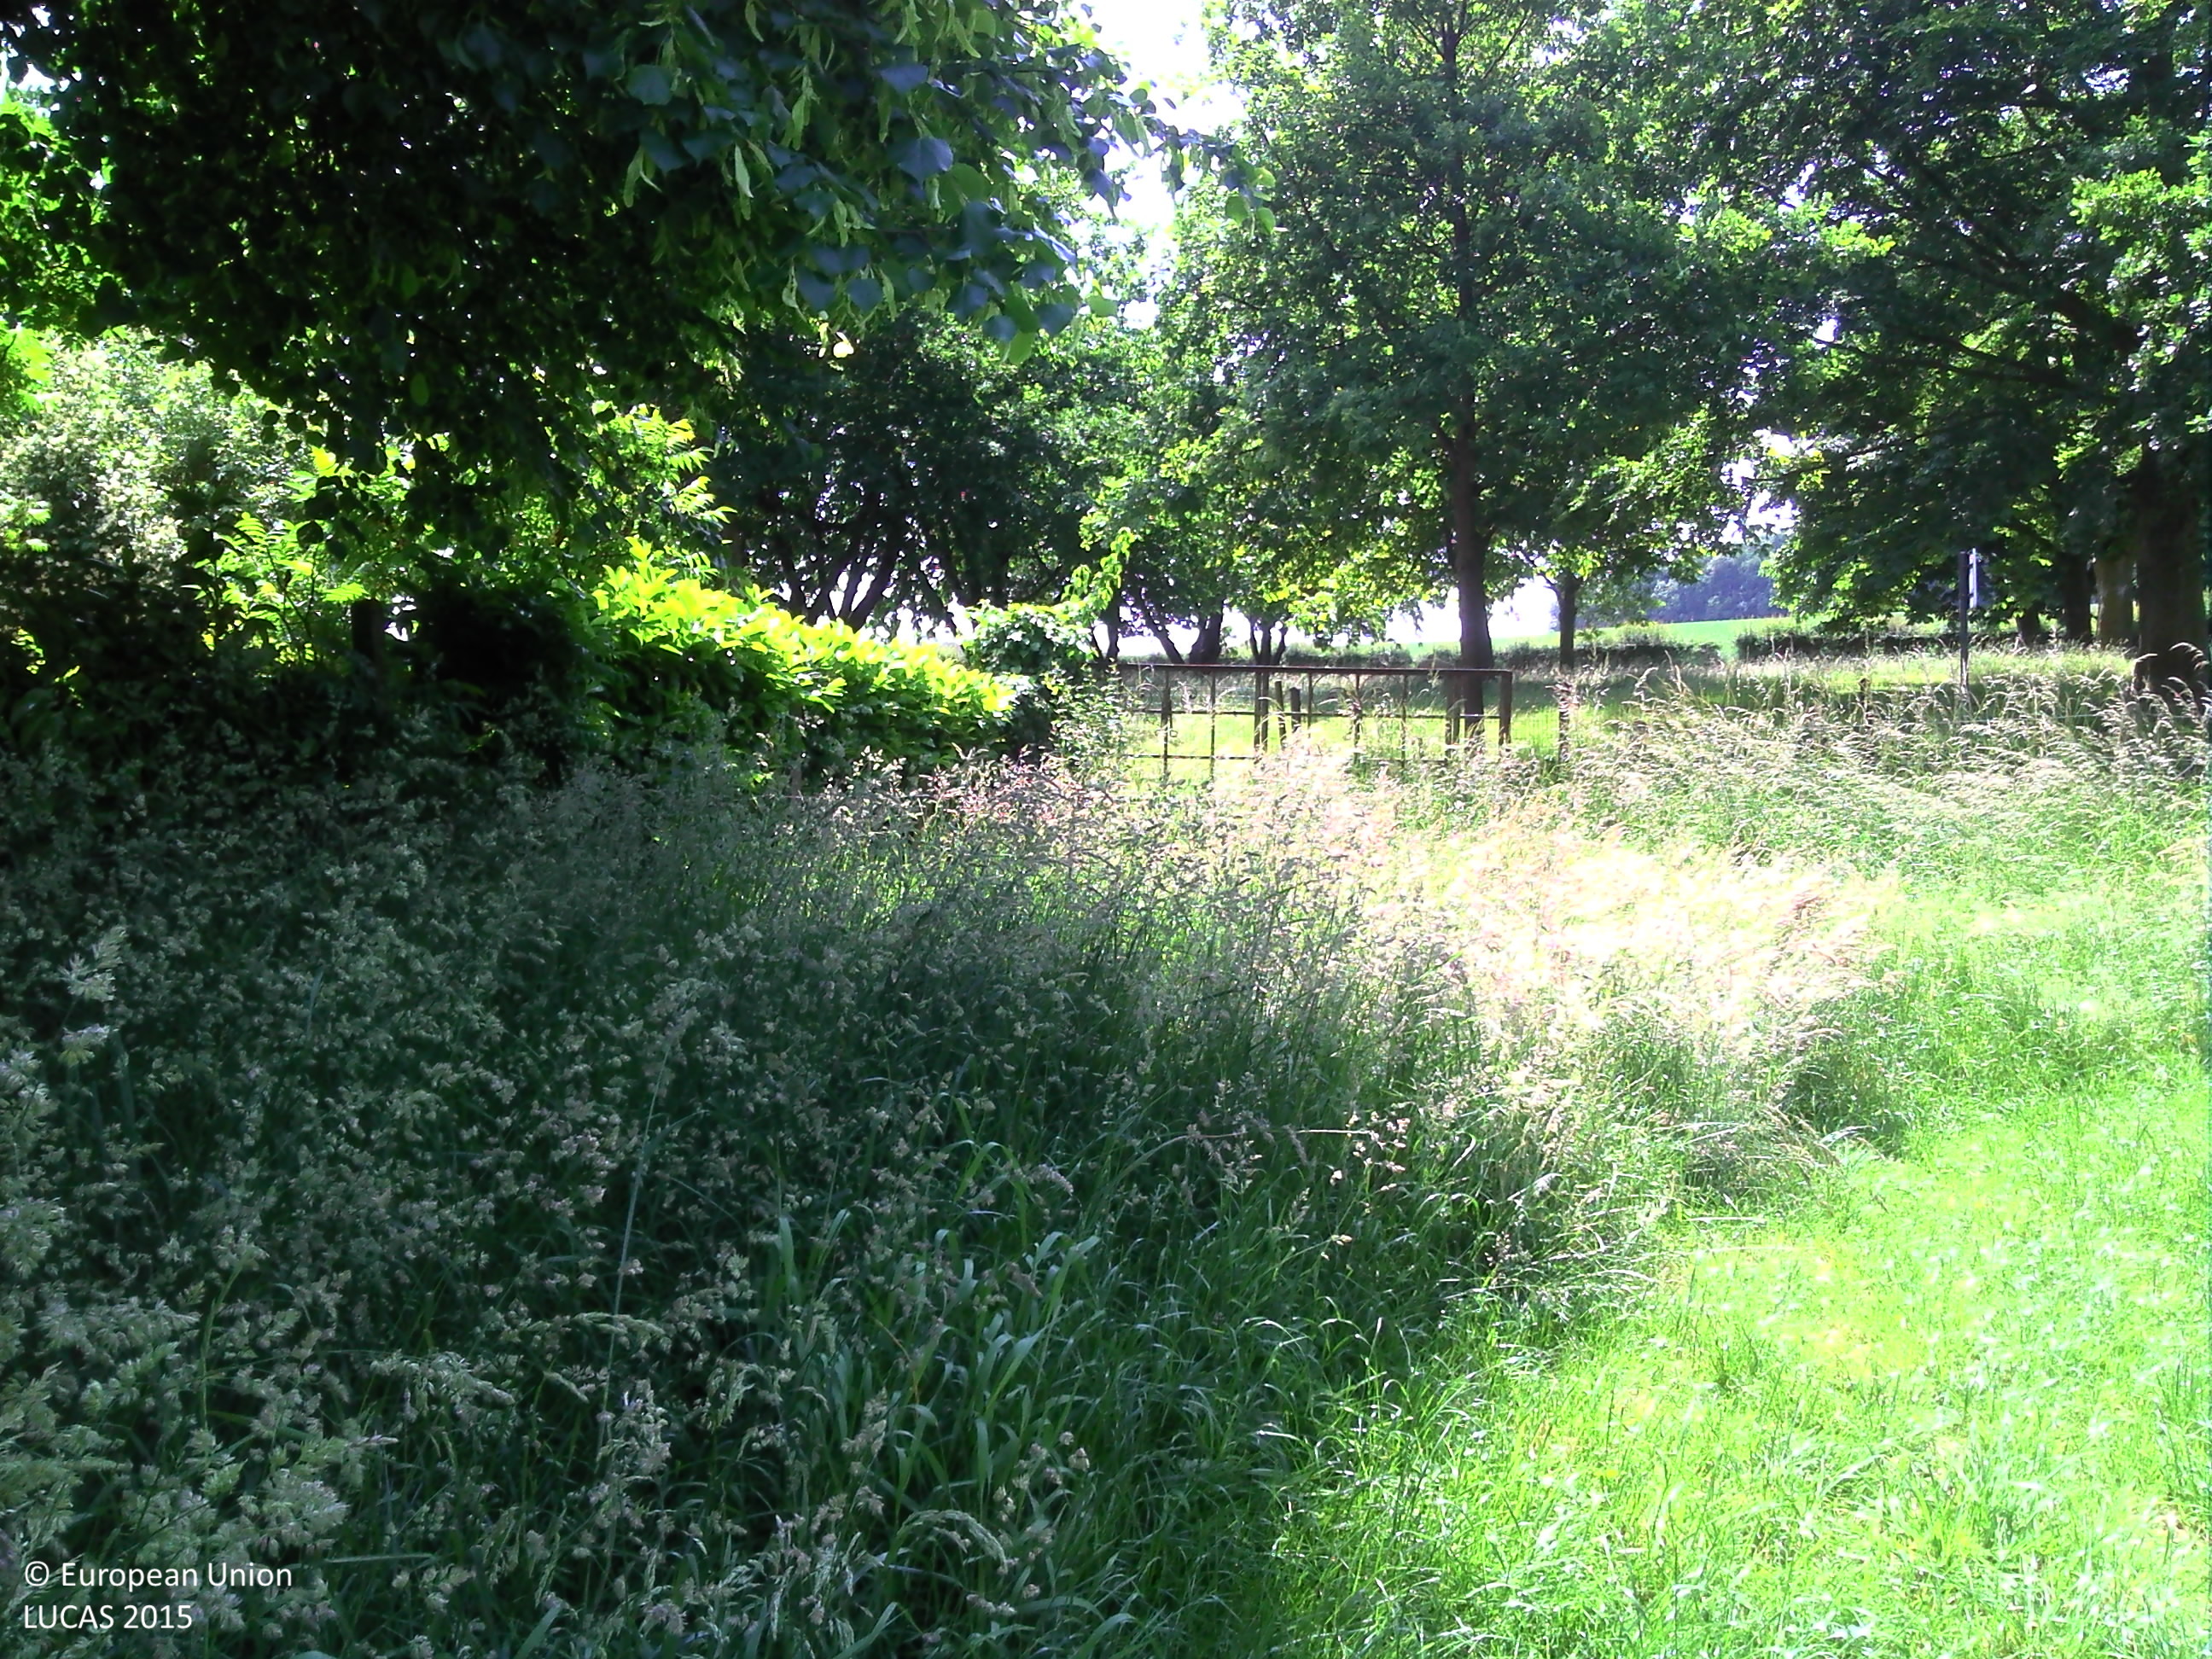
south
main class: Grassland
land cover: Grassland without tree/shrub cover
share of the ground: > 75 %
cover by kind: herbaceous plants 100 %
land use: Agriculture (excluding fallow land and kitchen gardens)
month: June
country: BE
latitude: 50.8135
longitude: 5.4422
